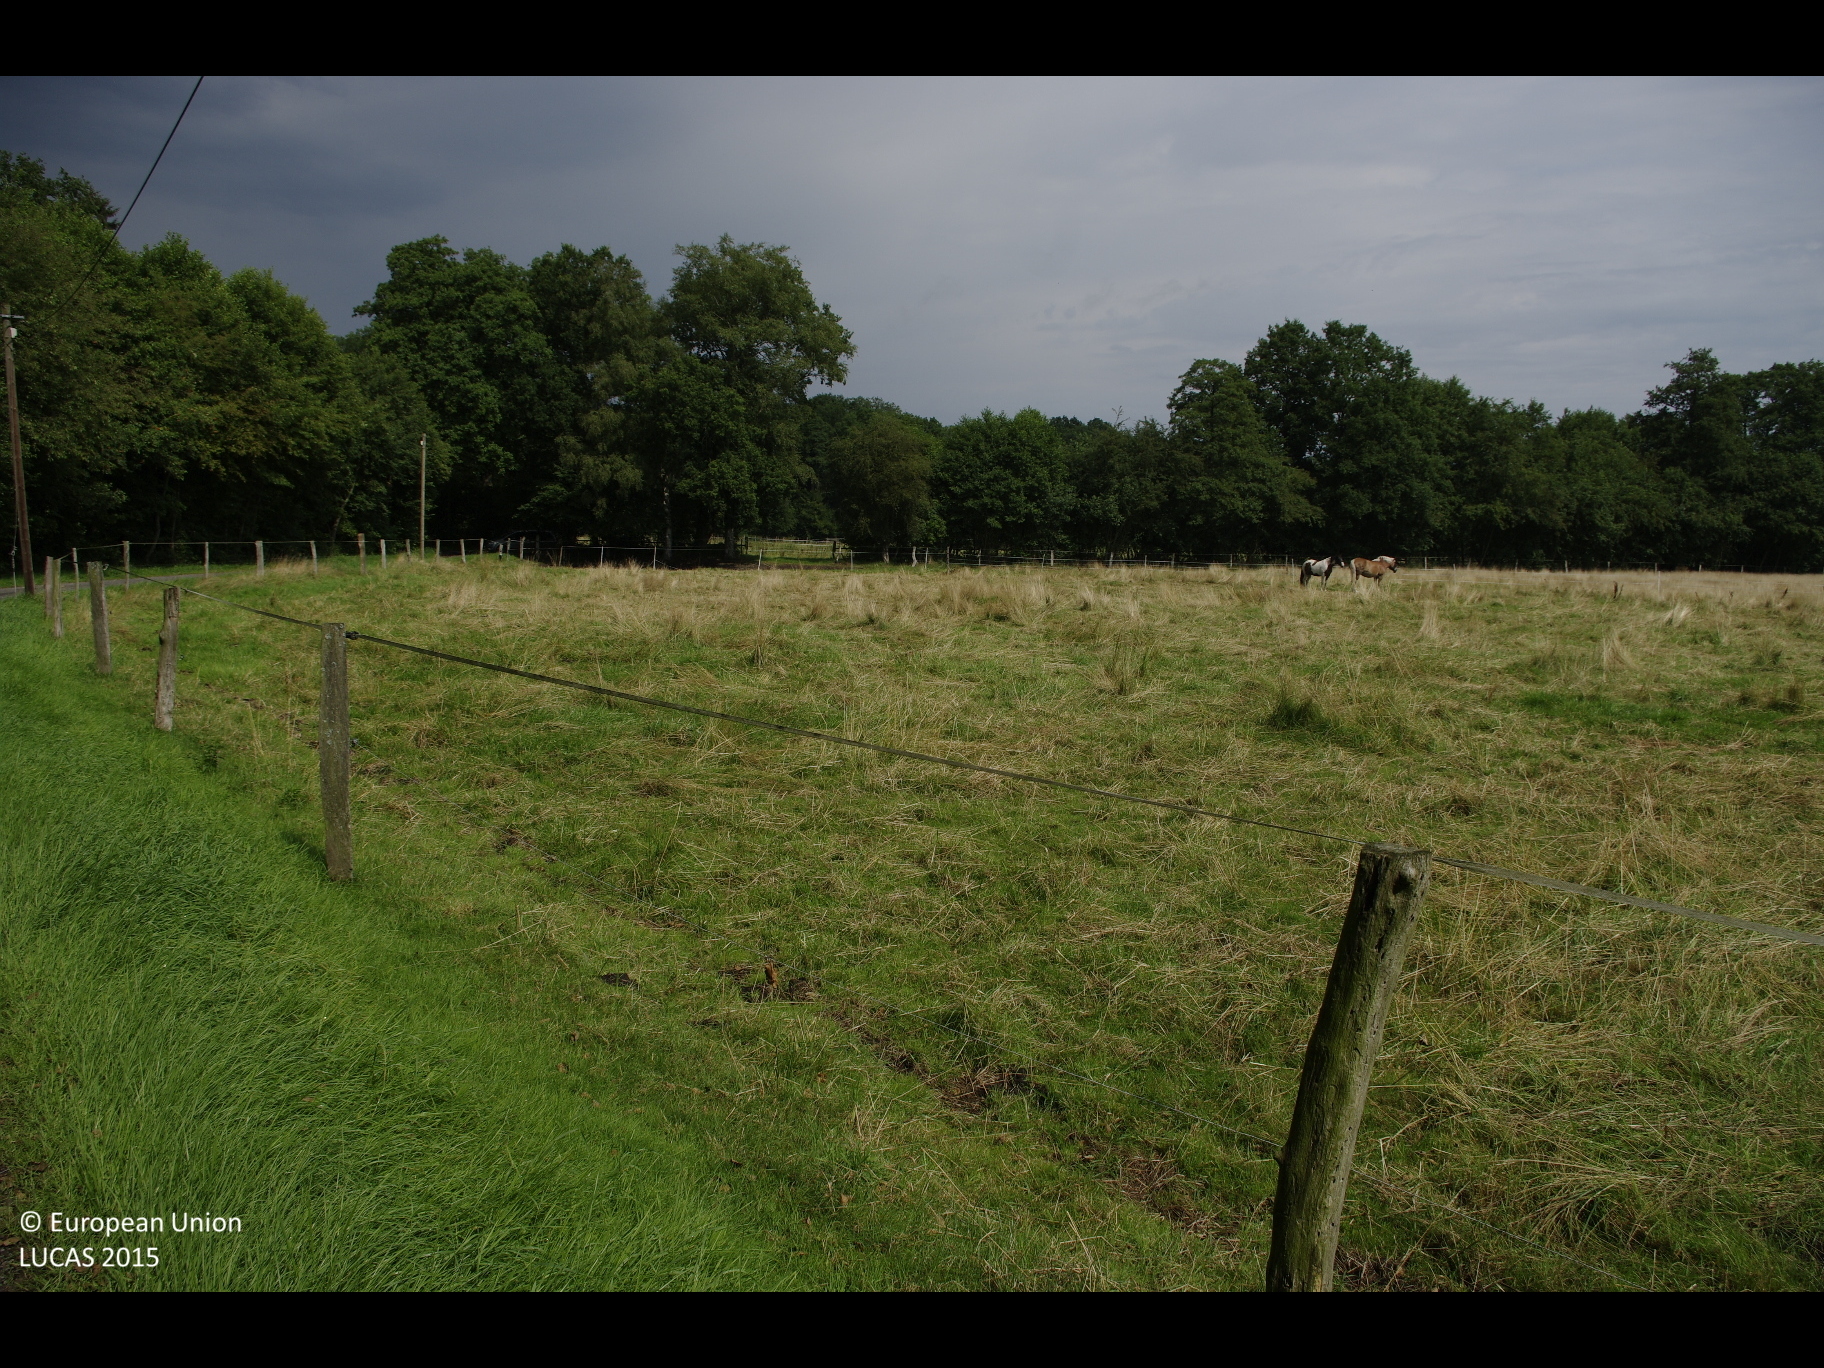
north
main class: Grassland
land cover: Grassland without tree/shrub cover
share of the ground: > 75 %
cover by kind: herbaceous plants 100 %
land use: Agriculture (excluding fallow land and kitchen gardens)
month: August
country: DE
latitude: 53.2581
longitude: 9.8652
